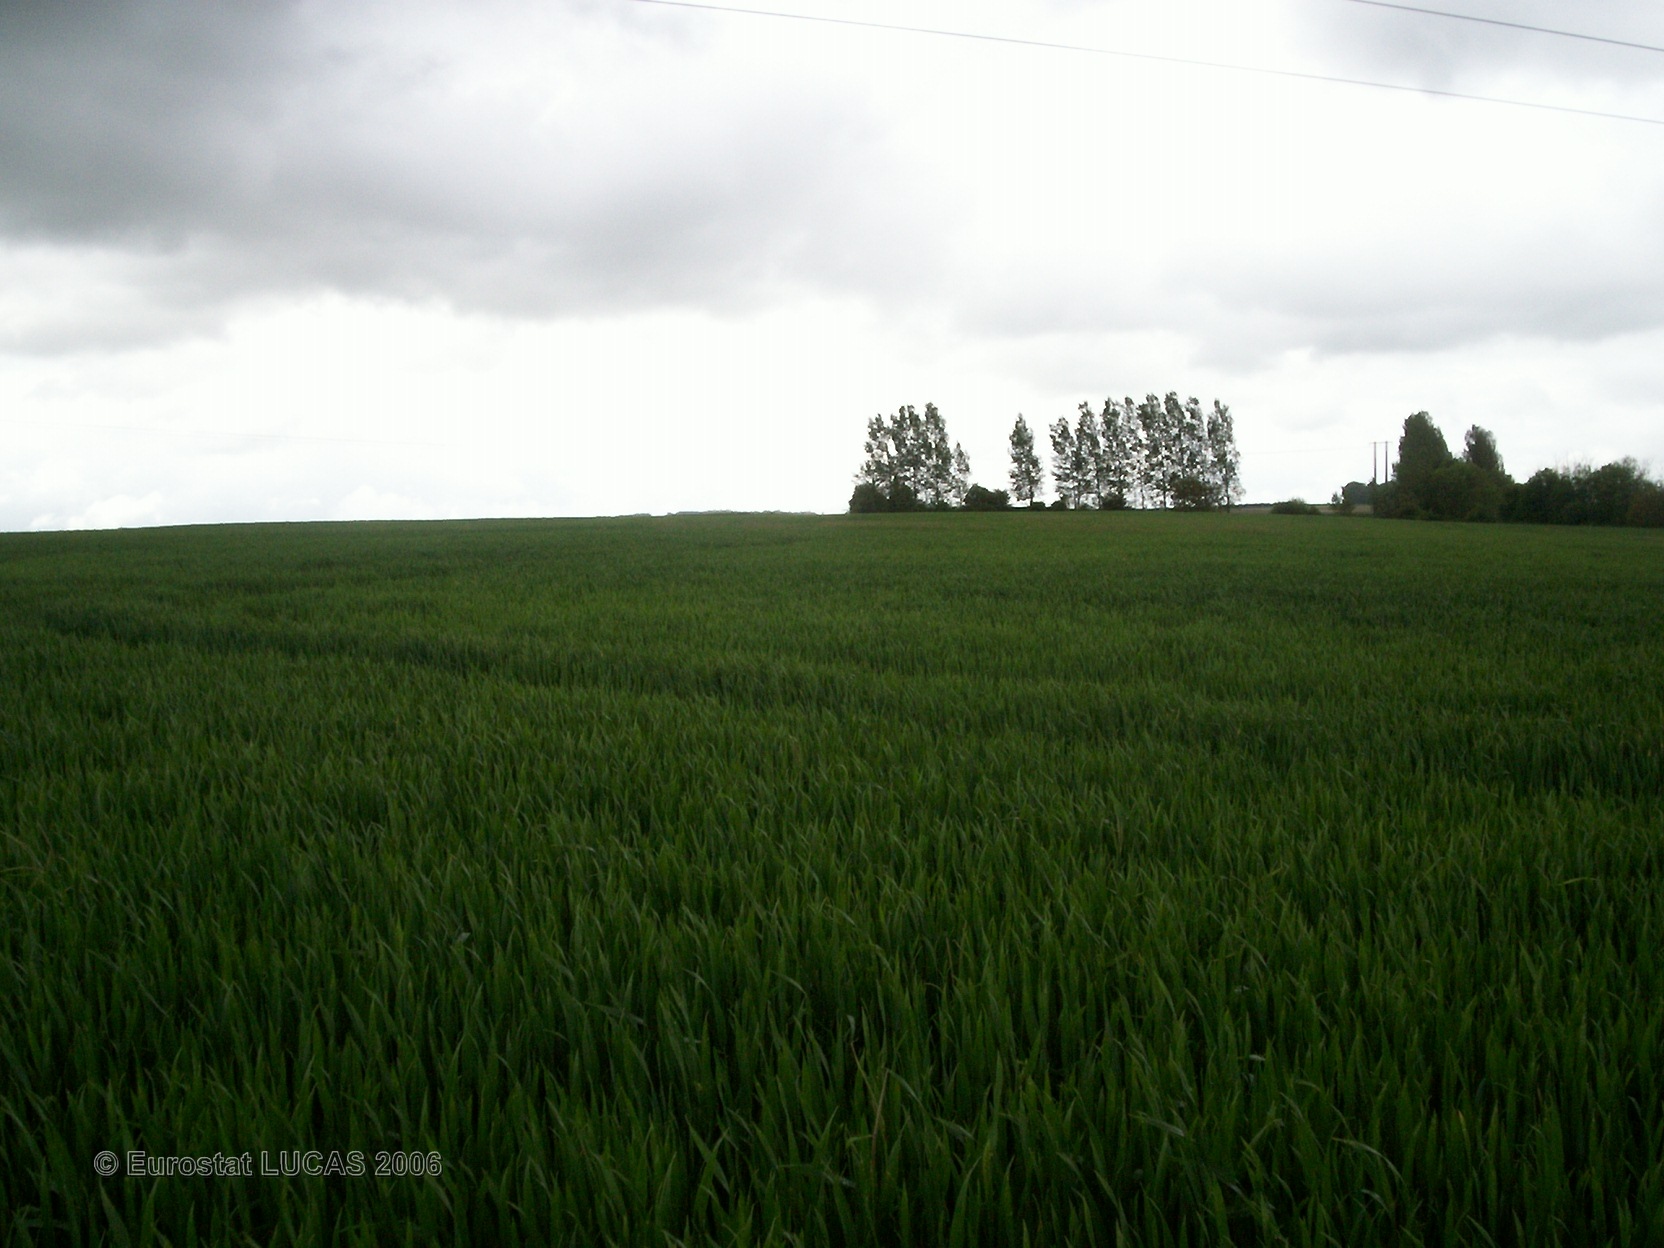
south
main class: Cropland
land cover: Common wheat
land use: Agriculture (excluding fallow land and kitchen gardens)
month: May
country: FR
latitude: 50.4452
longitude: 2.5382
